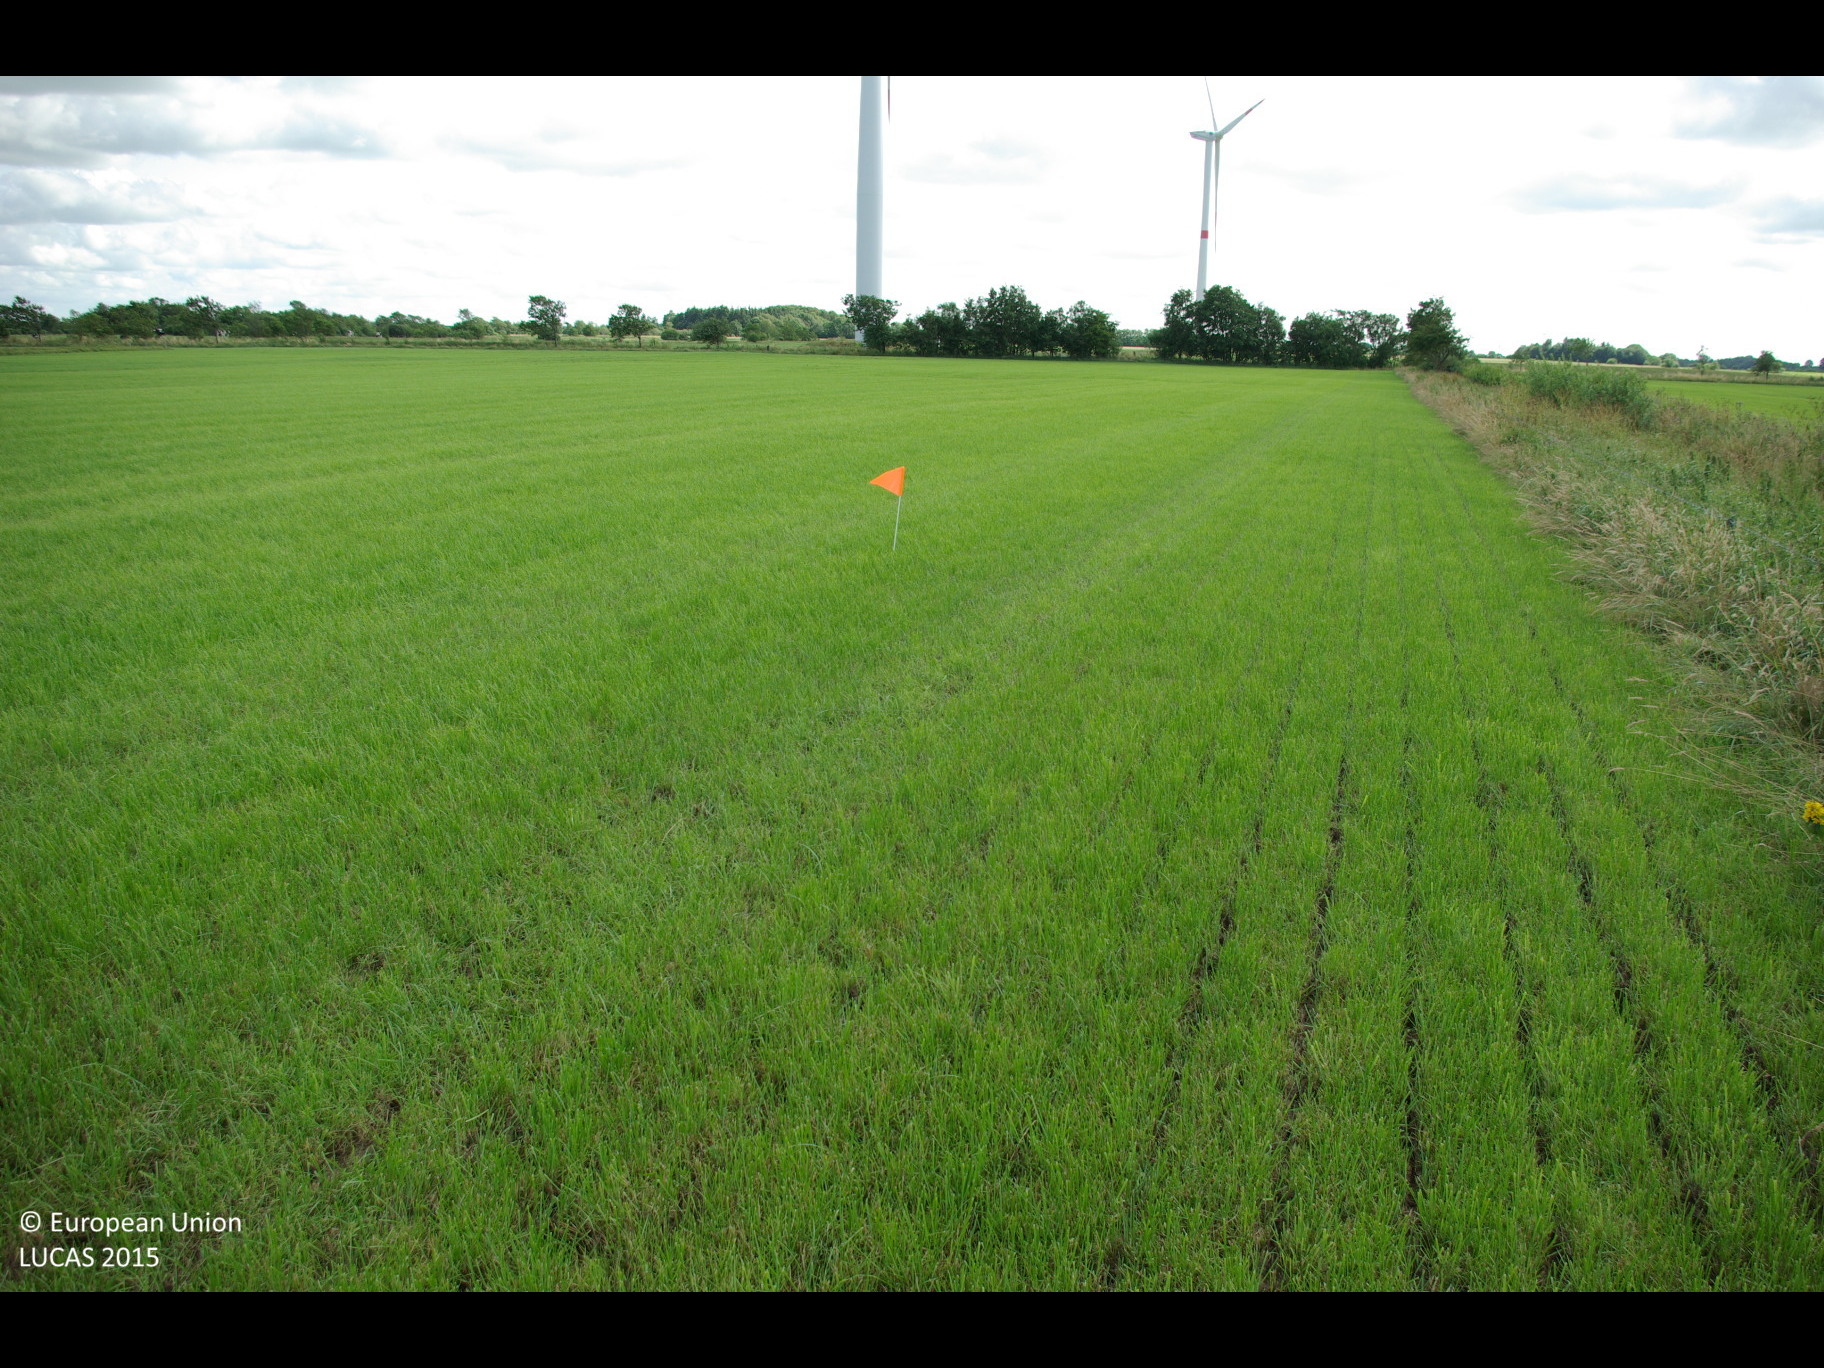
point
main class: Grassland
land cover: Grassland without tree/shrub cover
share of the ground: > 75 %
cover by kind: herbaceous plants 100 %
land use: Agriculture (excluding fallow land and kitchen gardens)
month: July
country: DE
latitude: 54.8010
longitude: 9.1761
